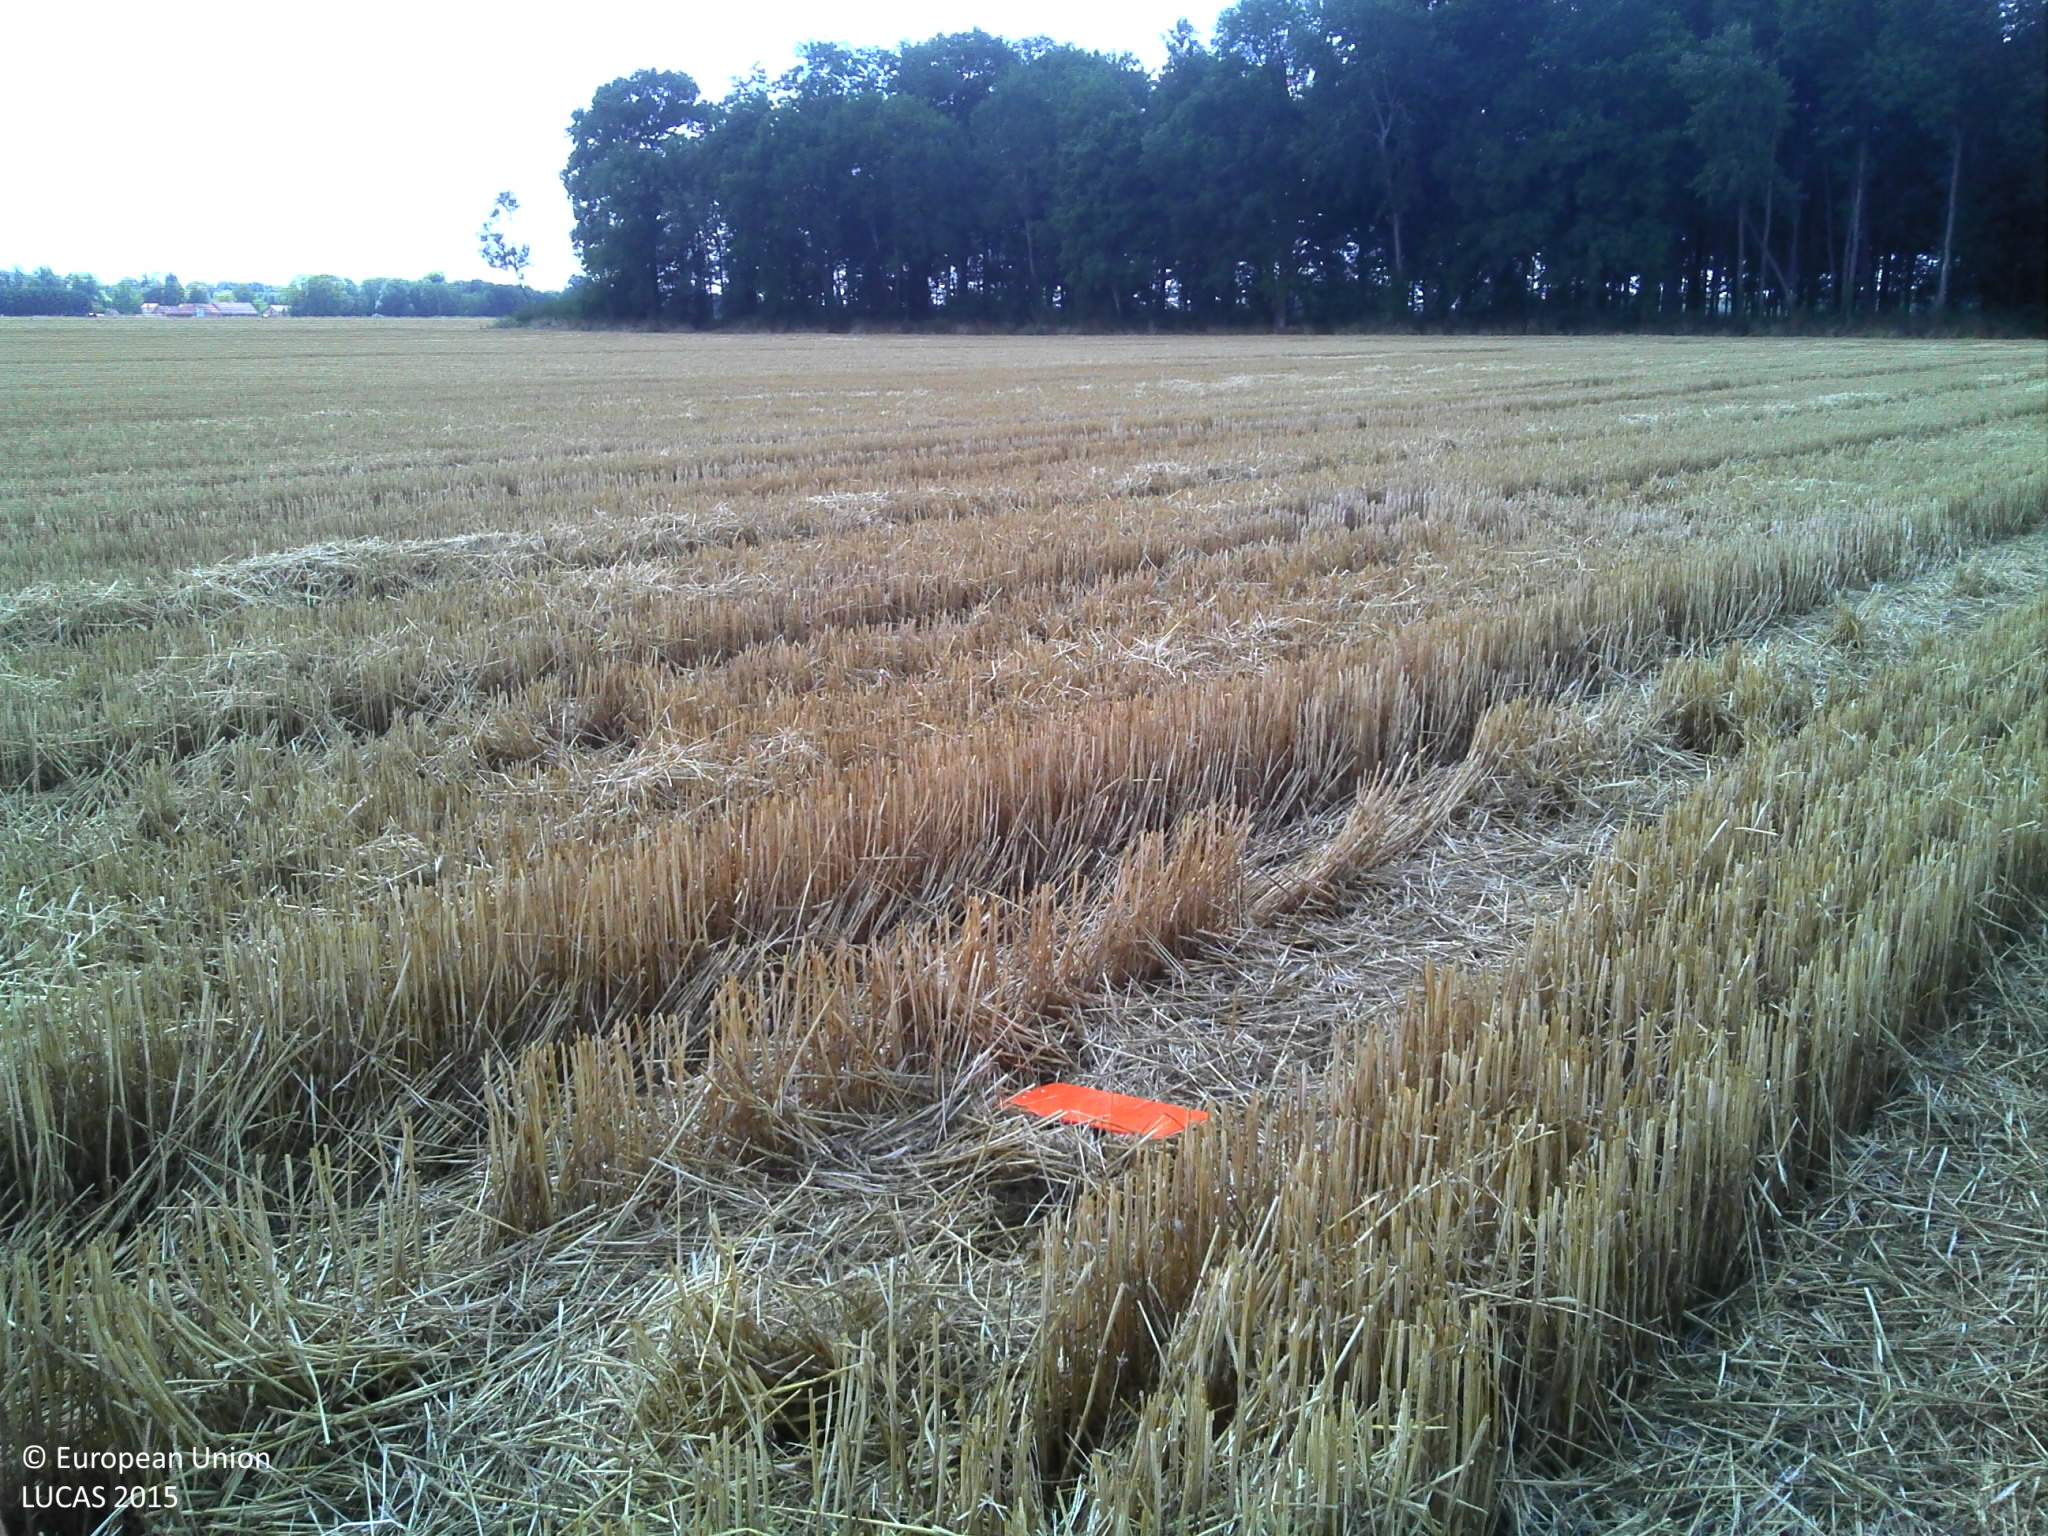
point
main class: Cropland
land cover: Common wheat
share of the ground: > 75 %
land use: Agriculture (excluding fallow land and kitchen gardens)
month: July
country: FR
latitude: 48.7210
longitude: 2.9638
